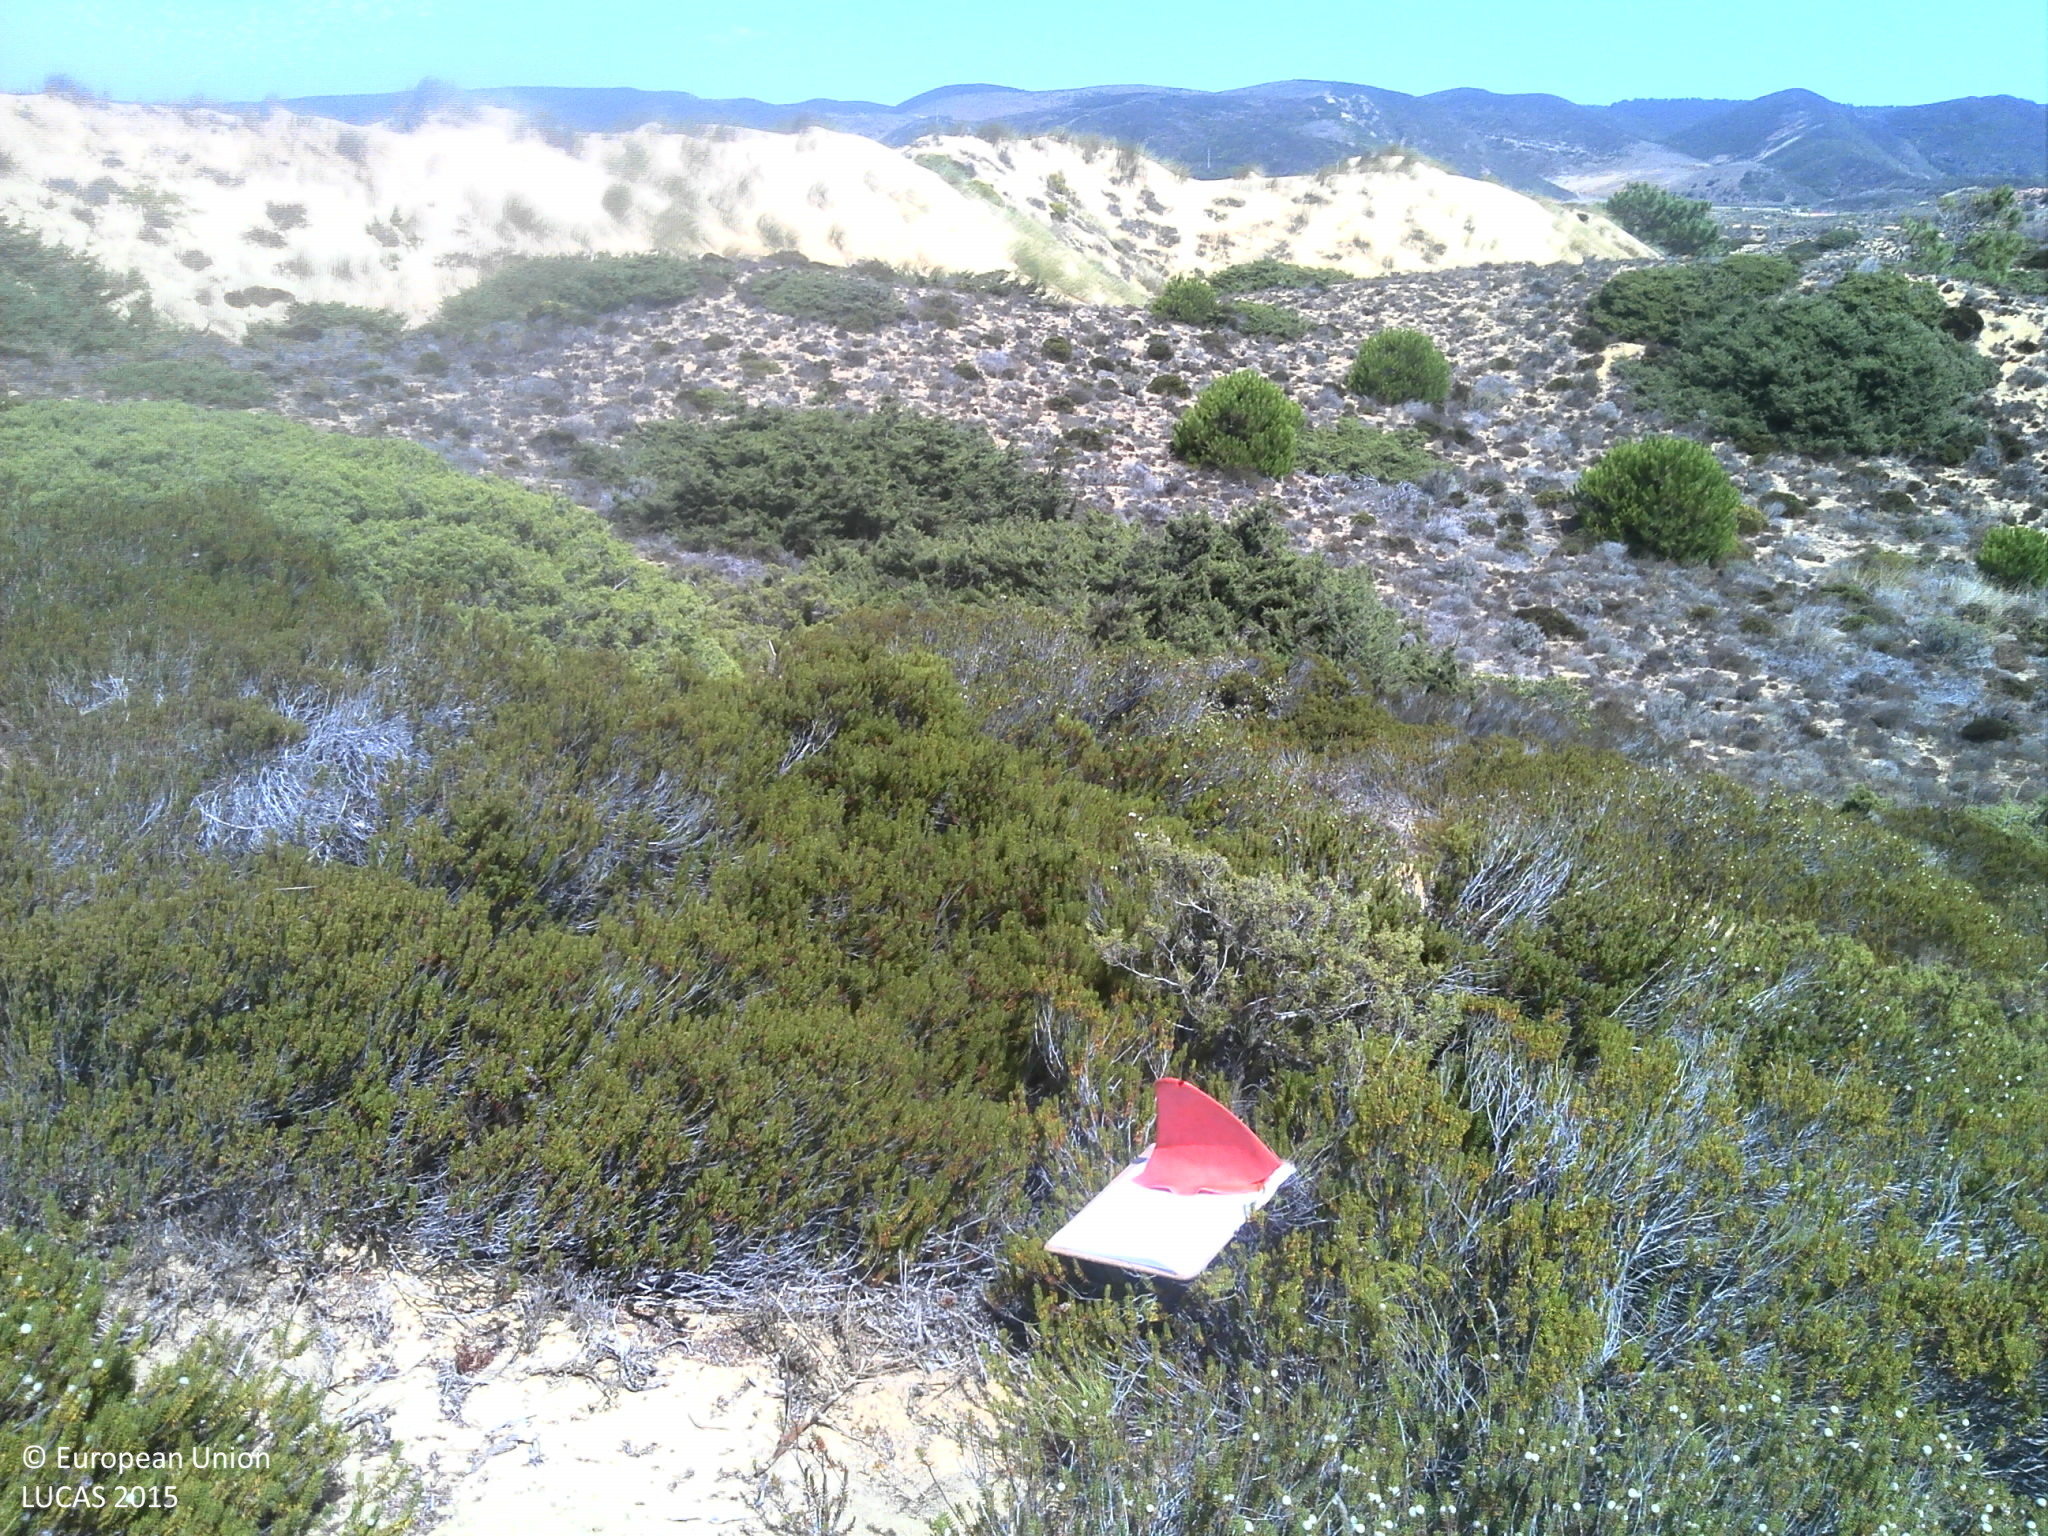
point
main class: Shrubland
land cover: Shrubland without tree cover
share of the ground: 50 - 75 %
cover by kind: shrubs 50 %, unconsolidated bare surface 40 %, herbaceous plants 10 %
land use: Semi-natural and natural areas not in use
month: August
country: PT
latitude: 37.1872
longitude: -8.9042
